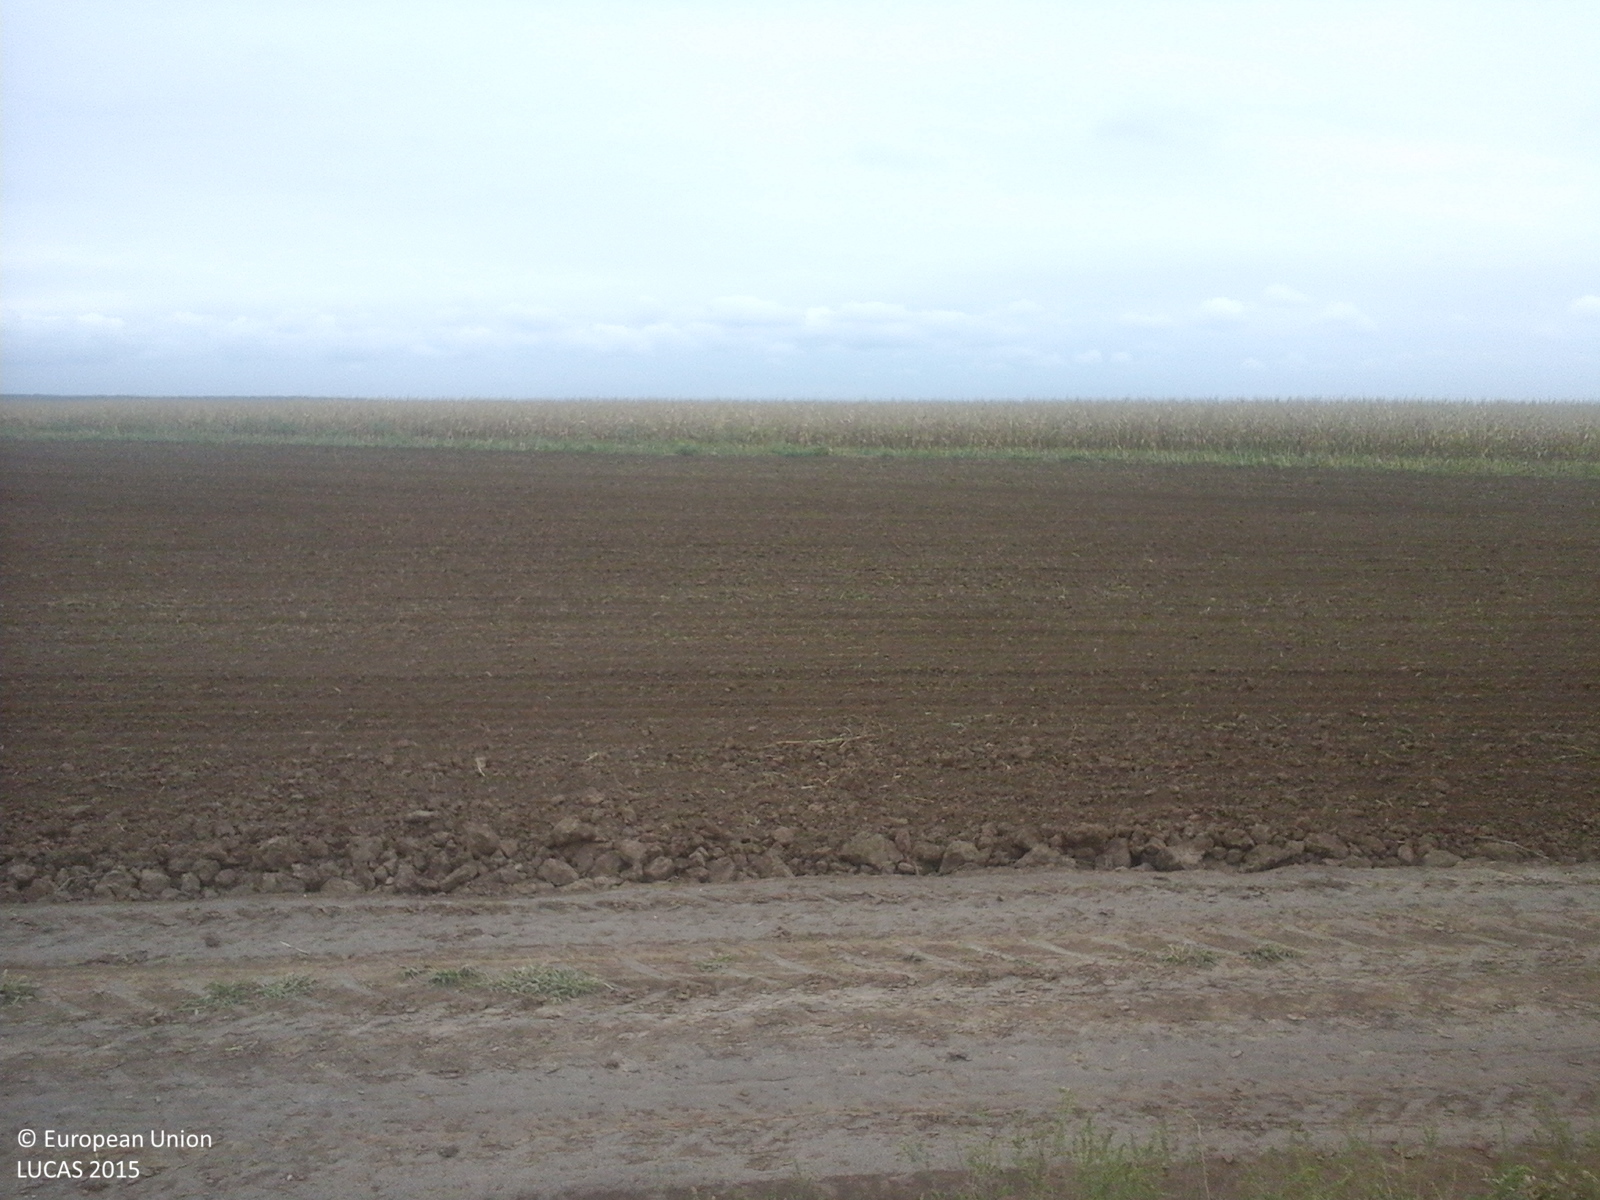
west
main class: Cropland
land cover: Sunflower
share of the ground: < 10 %
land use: Agriculture (excluding fallow land and kitchen gardens)
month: September
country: RO
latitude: 47.3497
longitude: 21.9755
